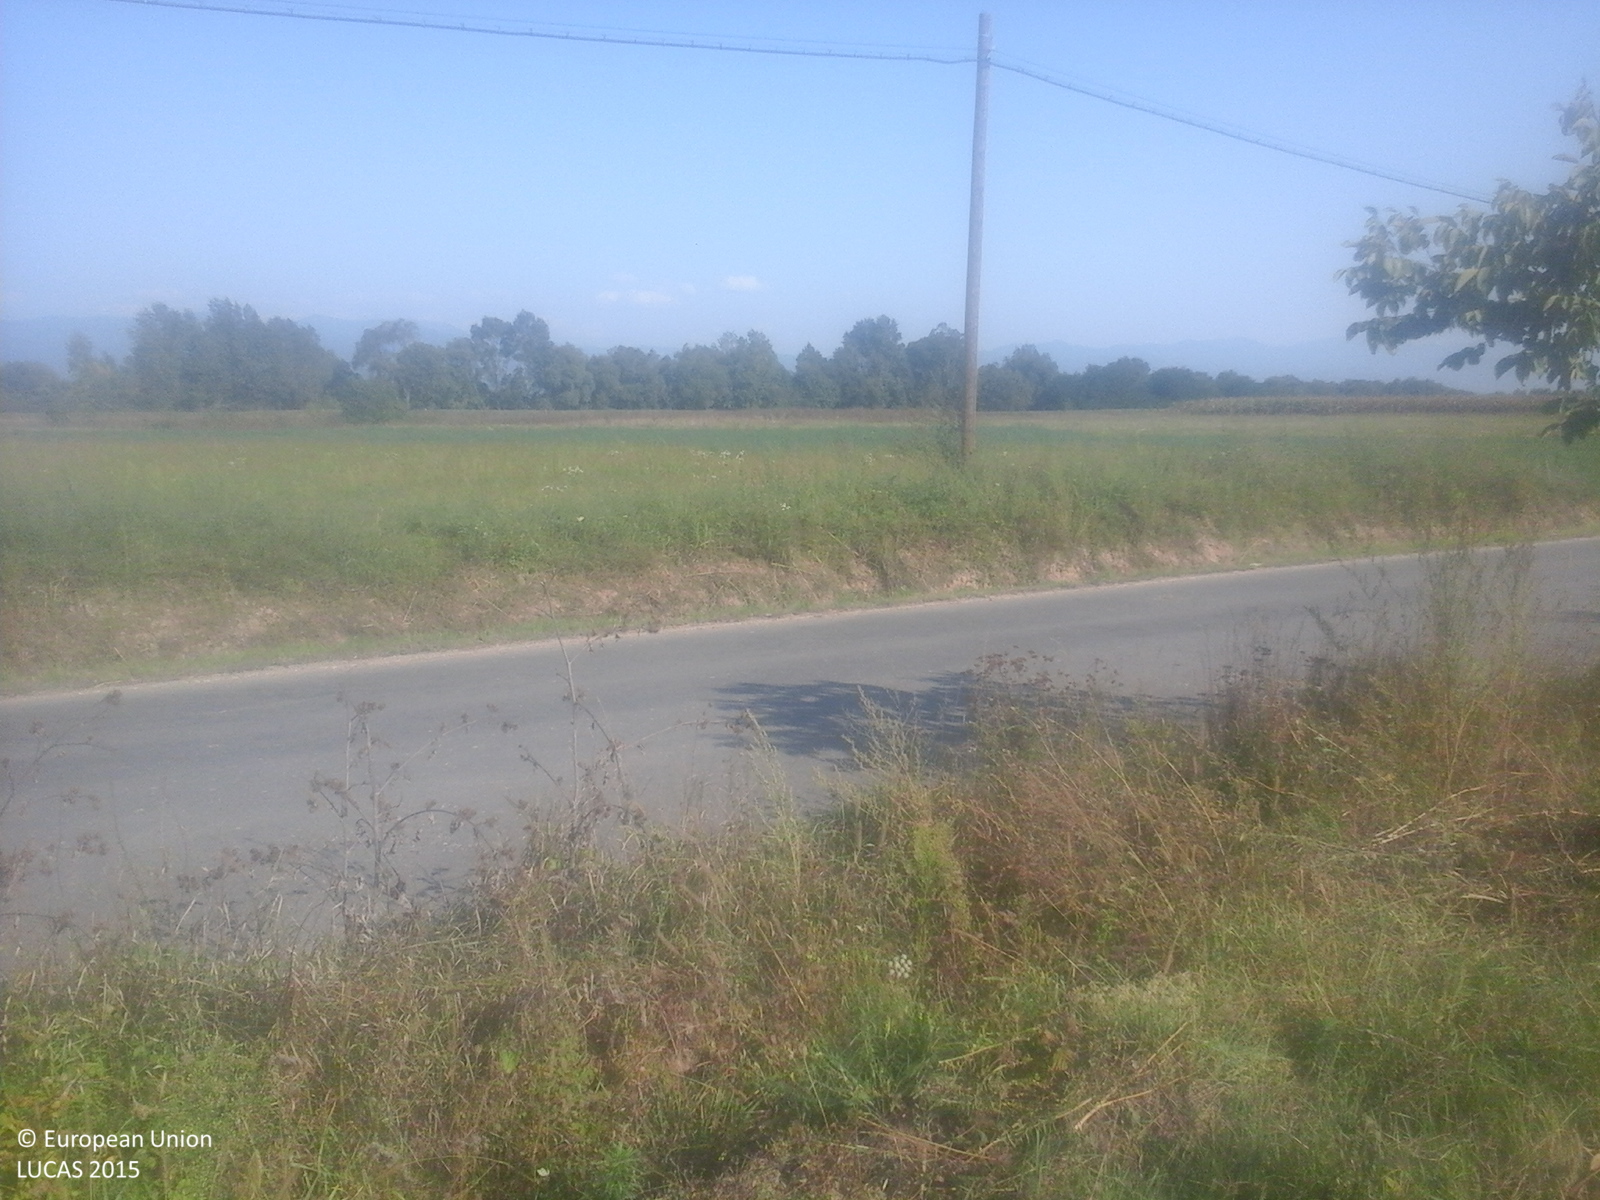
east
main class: Cropland
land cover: Potatoes
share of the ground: > 75 %
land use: Agriculture (excluding fallow land and kitchen gardens)
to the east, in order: Potatoes; Shruby margins; Ditches and canals; Shruby margins; Paved roads, cycling and walking lanes; Grass margins; Ditches and canals; Shruby margins; Electric lines; Grassland without tree/shrub cover; Lucerne; Spontaneously vegetated surfaces; Grassland with sparse tree/shrub cover; Spontaneously vegetated surfaces; Tracks; Spontaneously vegetated surfaces; Rocks and stones
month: September
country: RO
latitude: 46.6526
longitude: 22.3459
